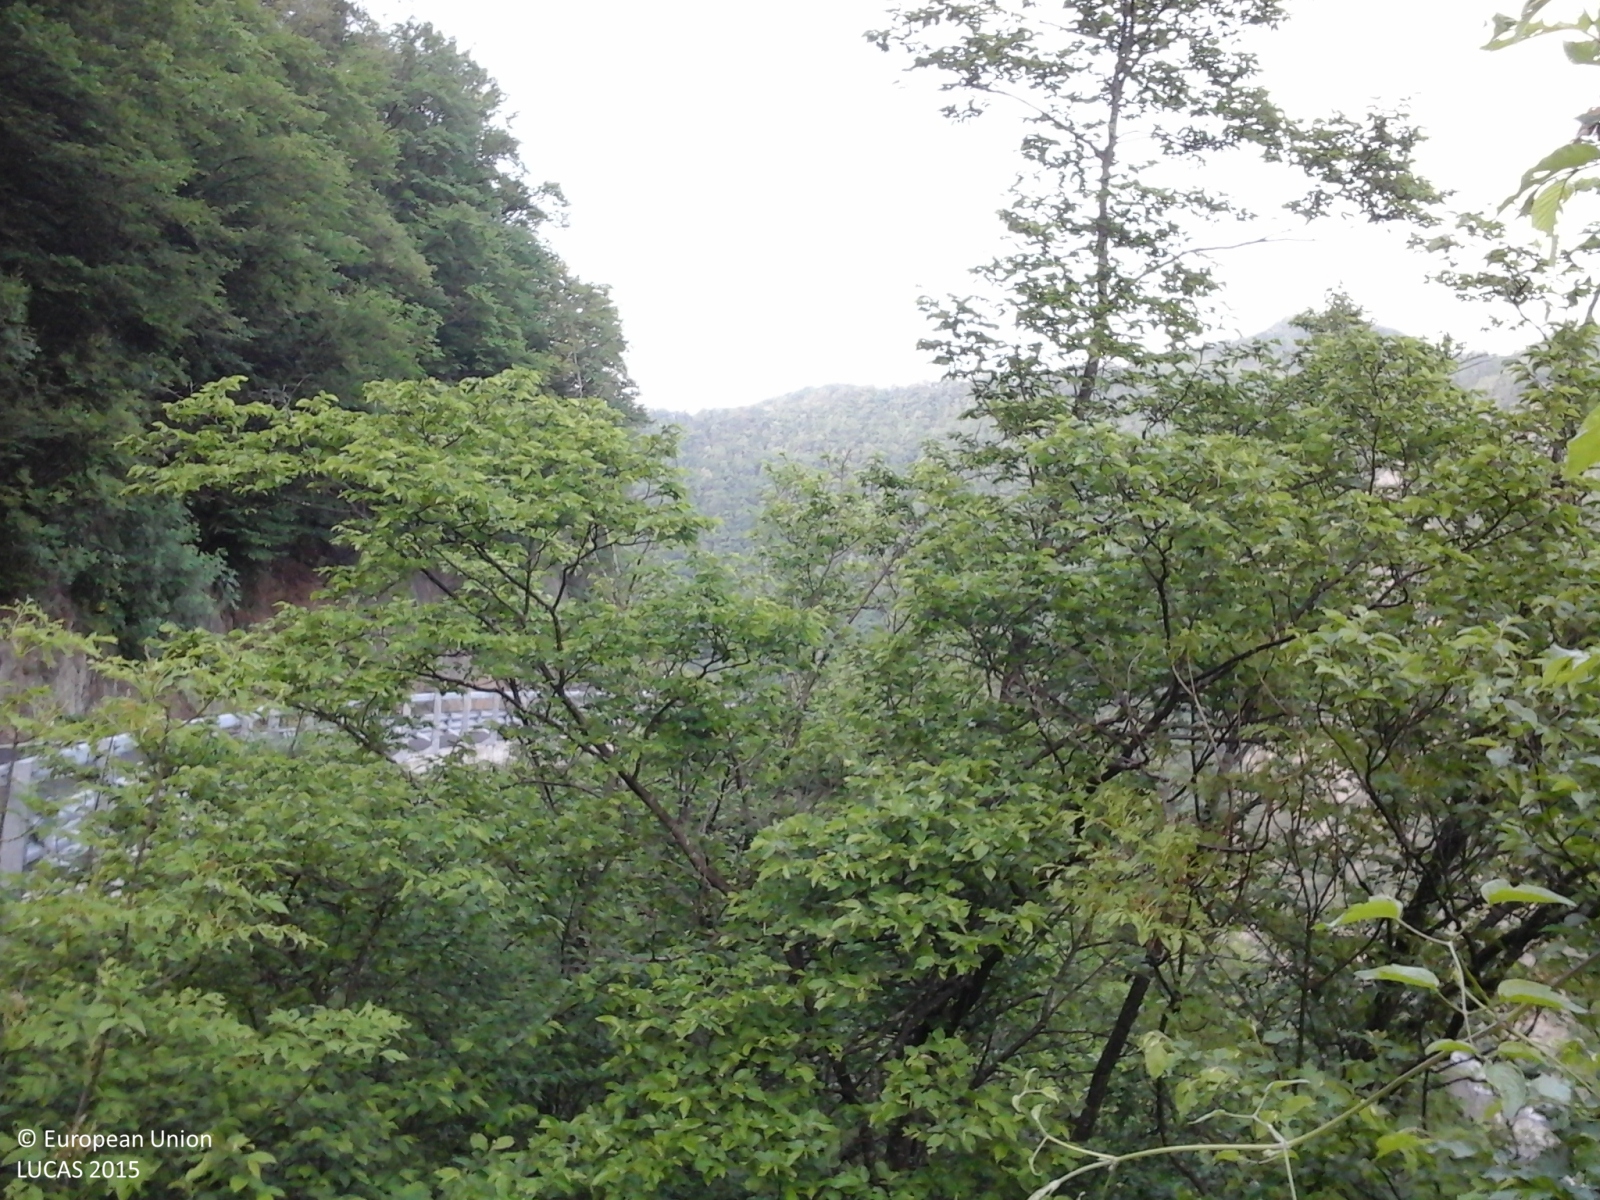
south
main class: Woodland
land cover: Broadleaved woodland
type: mesophytic deciduous forest
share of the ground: > 75 %
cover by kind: broadleaved forest trees 100 %
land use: Forestry
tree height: > 5 m
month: May
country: IT
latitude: 44.7274
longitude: 9.3826
